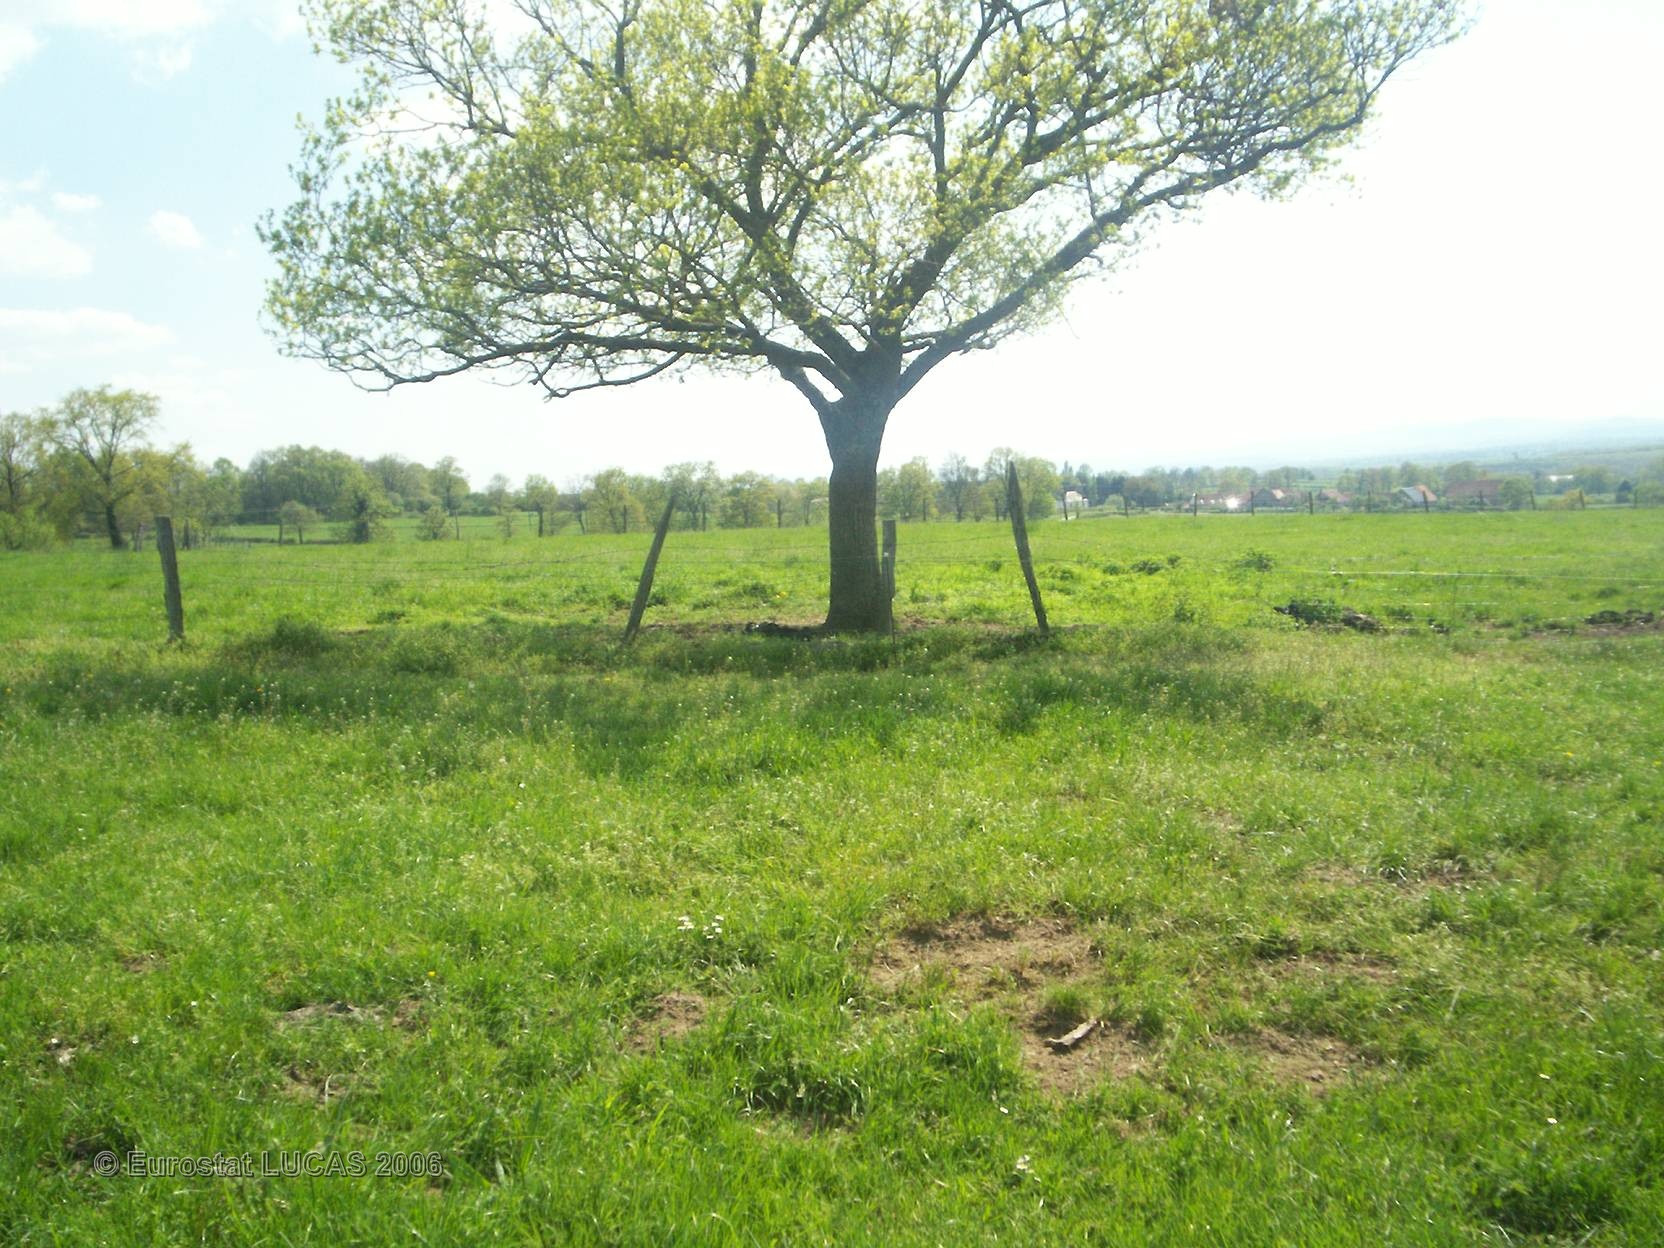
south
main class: Grassland
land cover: Grassland without tree/shrub cover
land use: Agriculture (excluding fallow land and kitchen gardens)
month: May
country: FR
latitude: 46.3288
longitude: 3.1266
